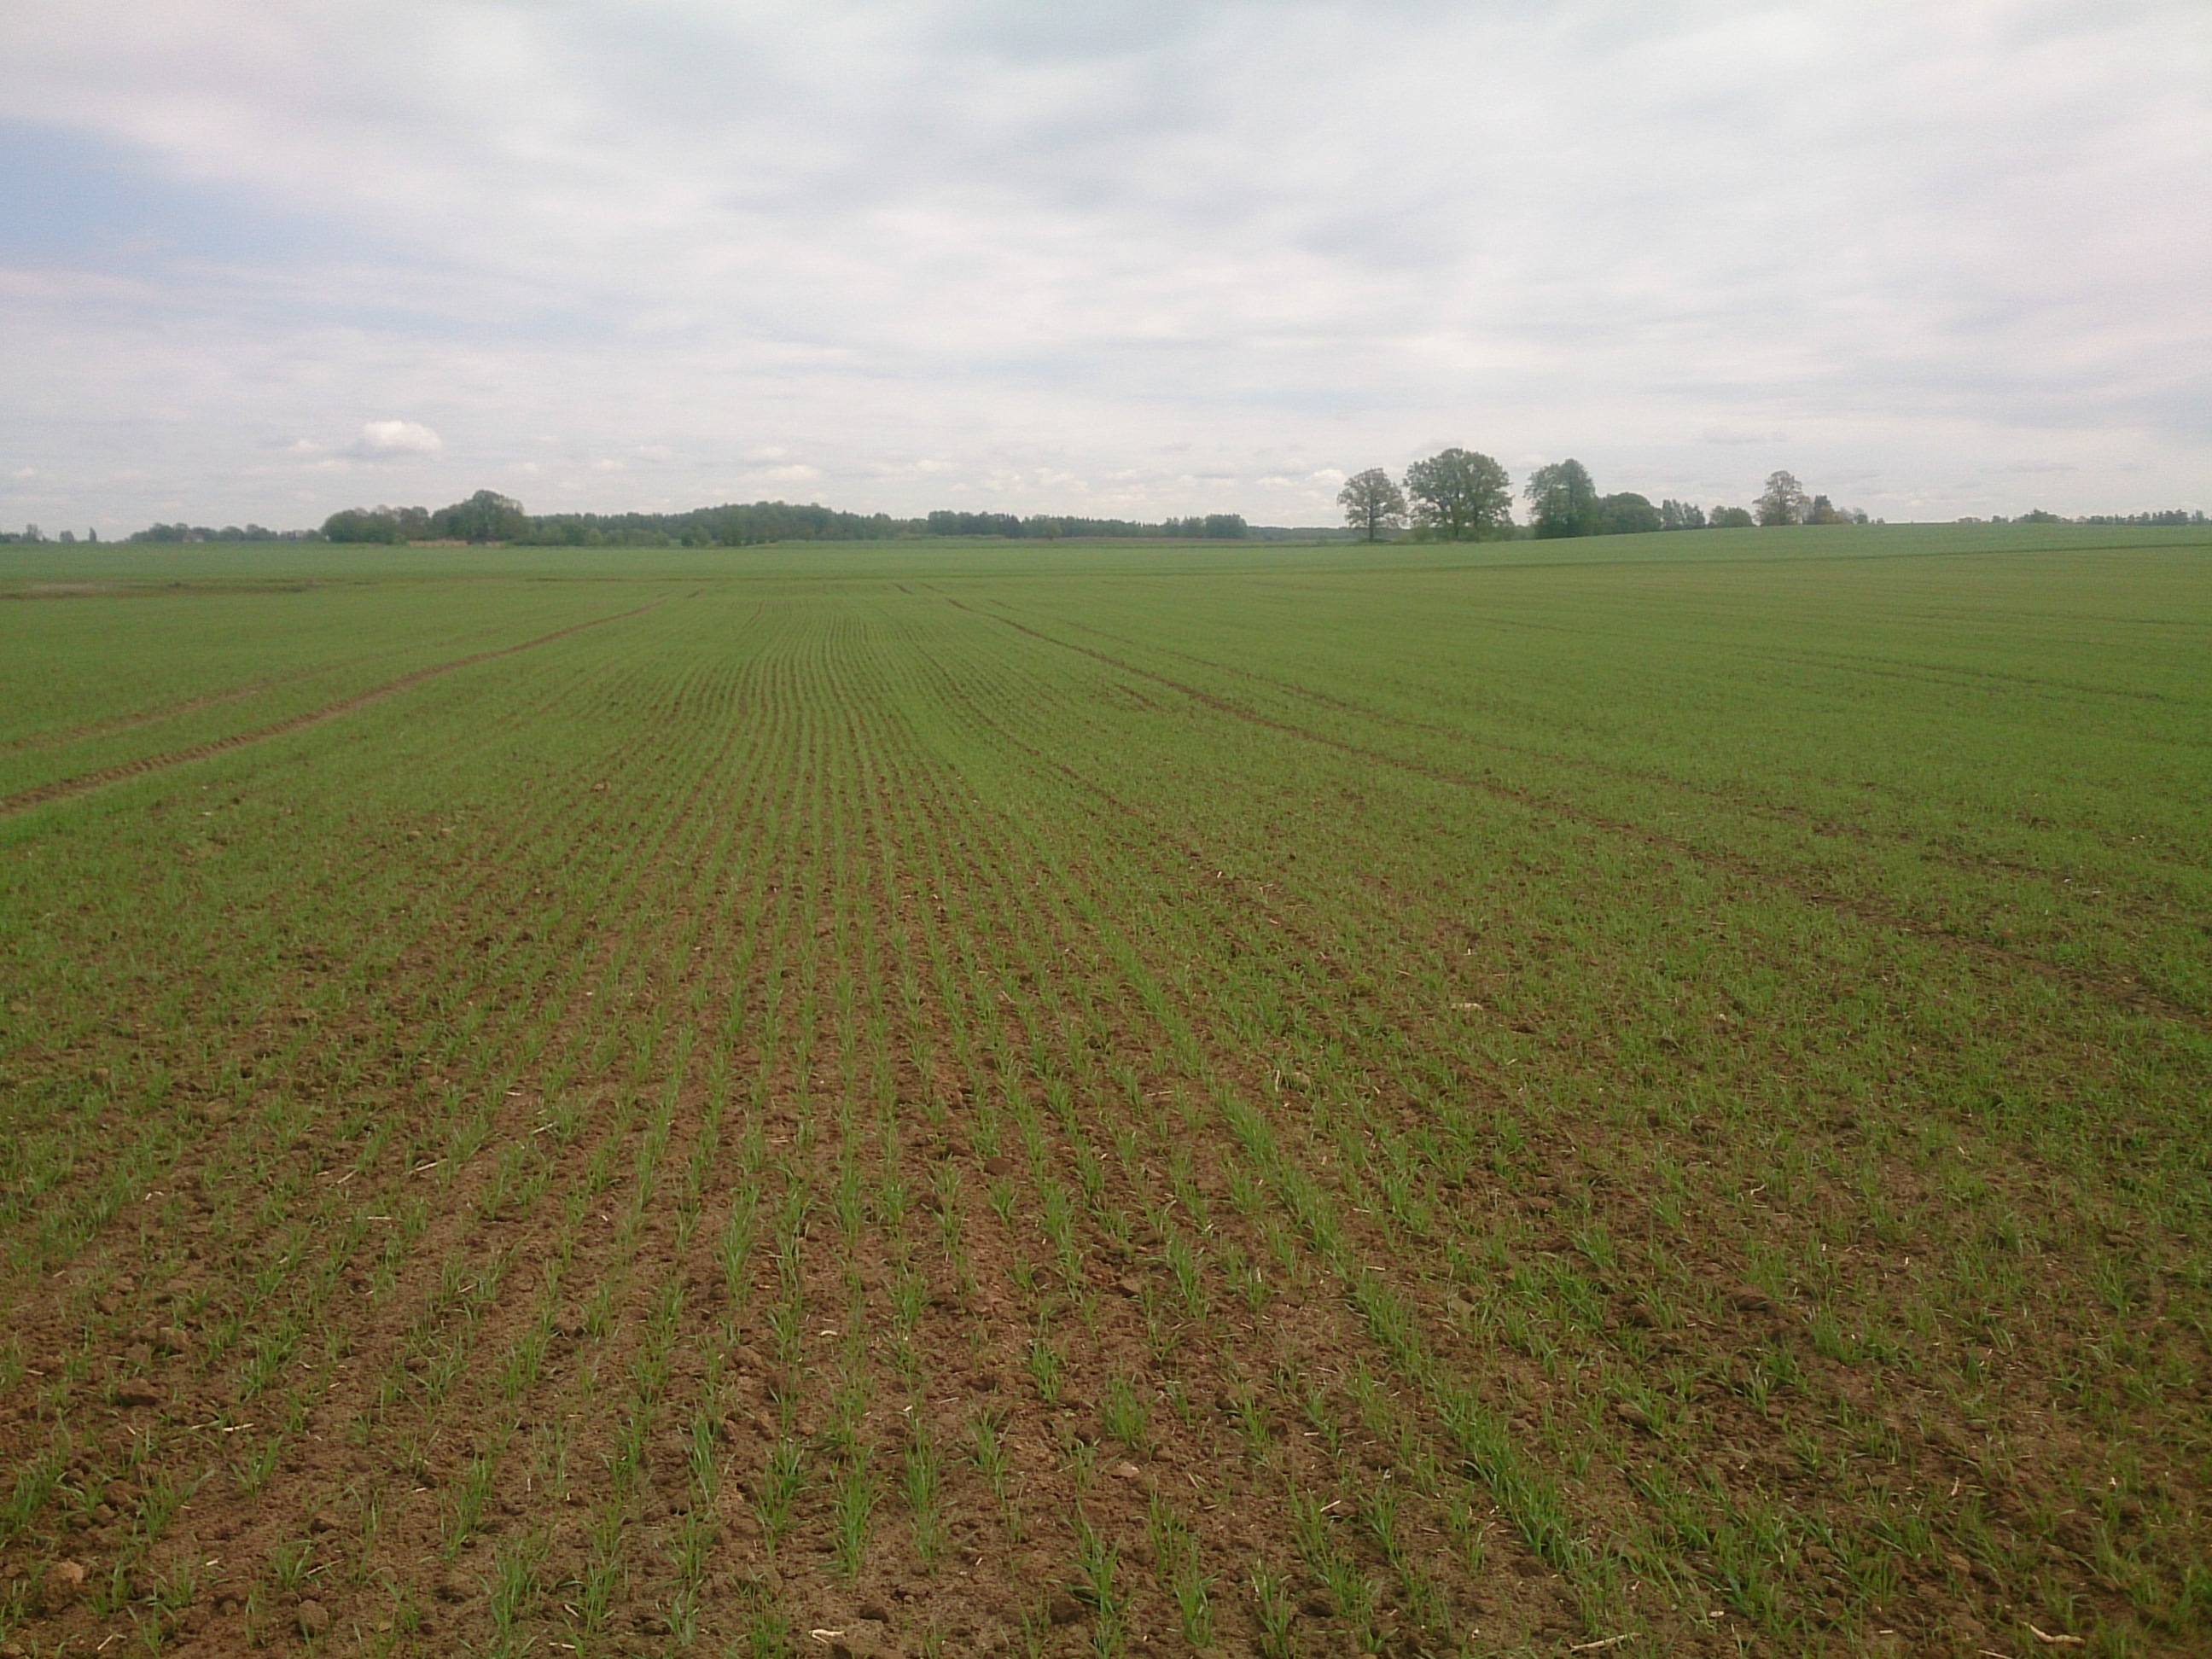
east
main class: Cropland
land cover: Common wheat
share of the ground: 50 - 75 %
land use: Agriculture (excluding fallow land and kitchen gardens)
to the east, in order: Common wheat
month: May
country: LV
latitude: 56.5143
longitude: 24.1456
